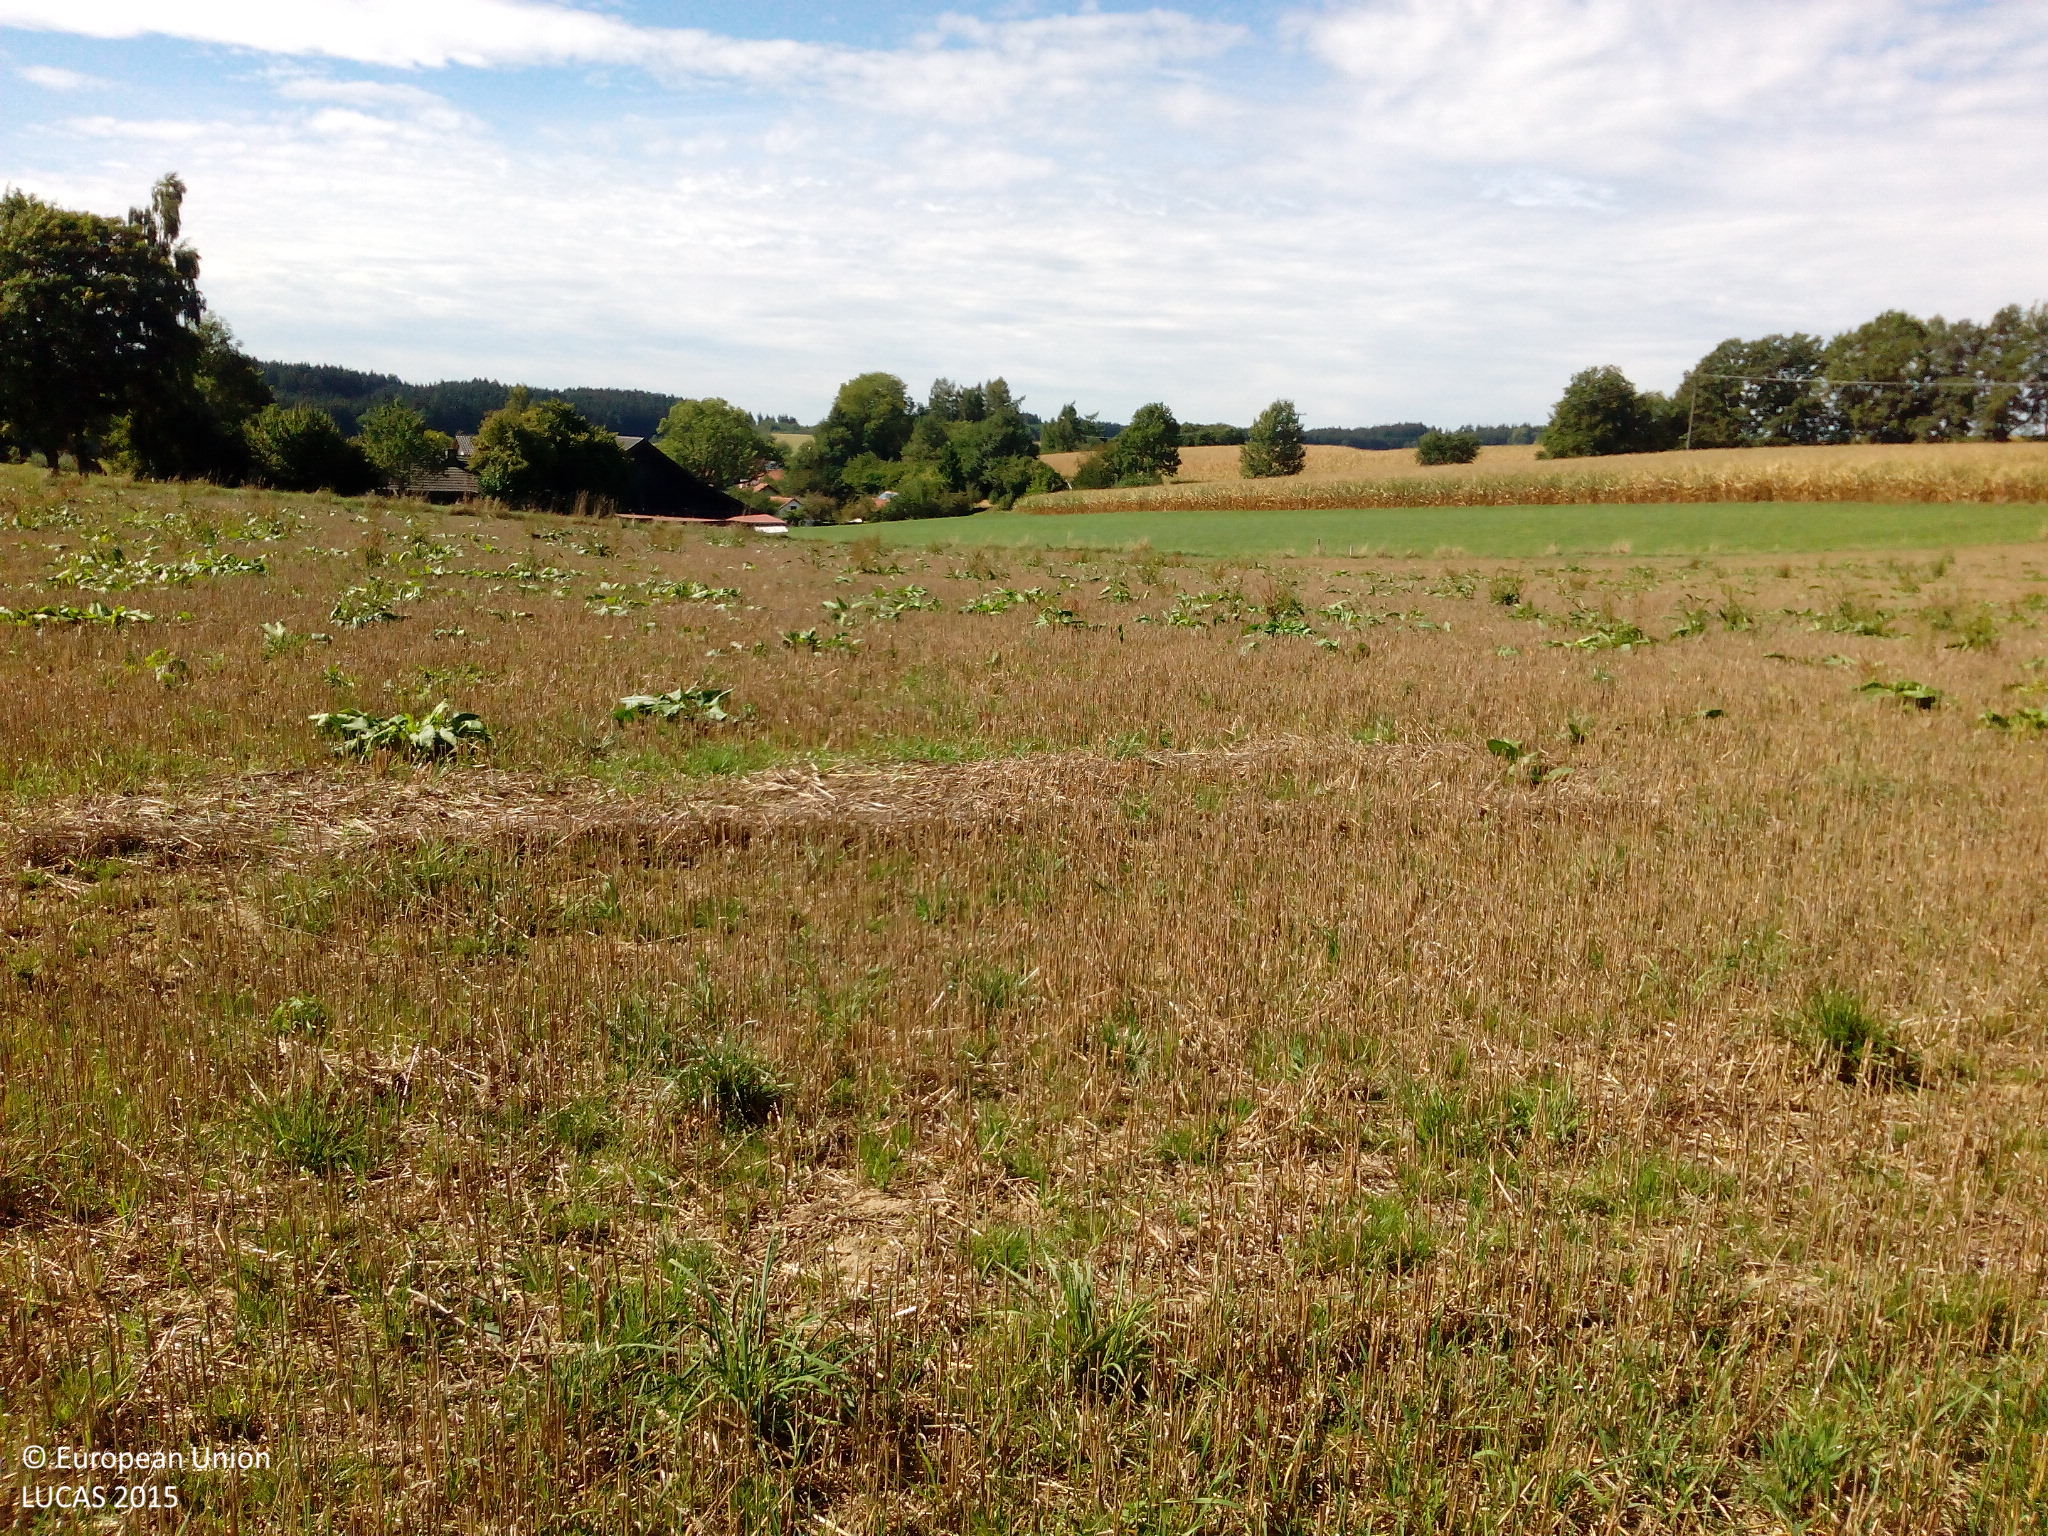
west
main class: Cropland
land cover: Maize
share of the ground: > 75 %
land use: Agriculture (excluding fallow land and kitchen gardens)
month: September
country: DE
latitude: 48.3842
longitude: 12.0650
